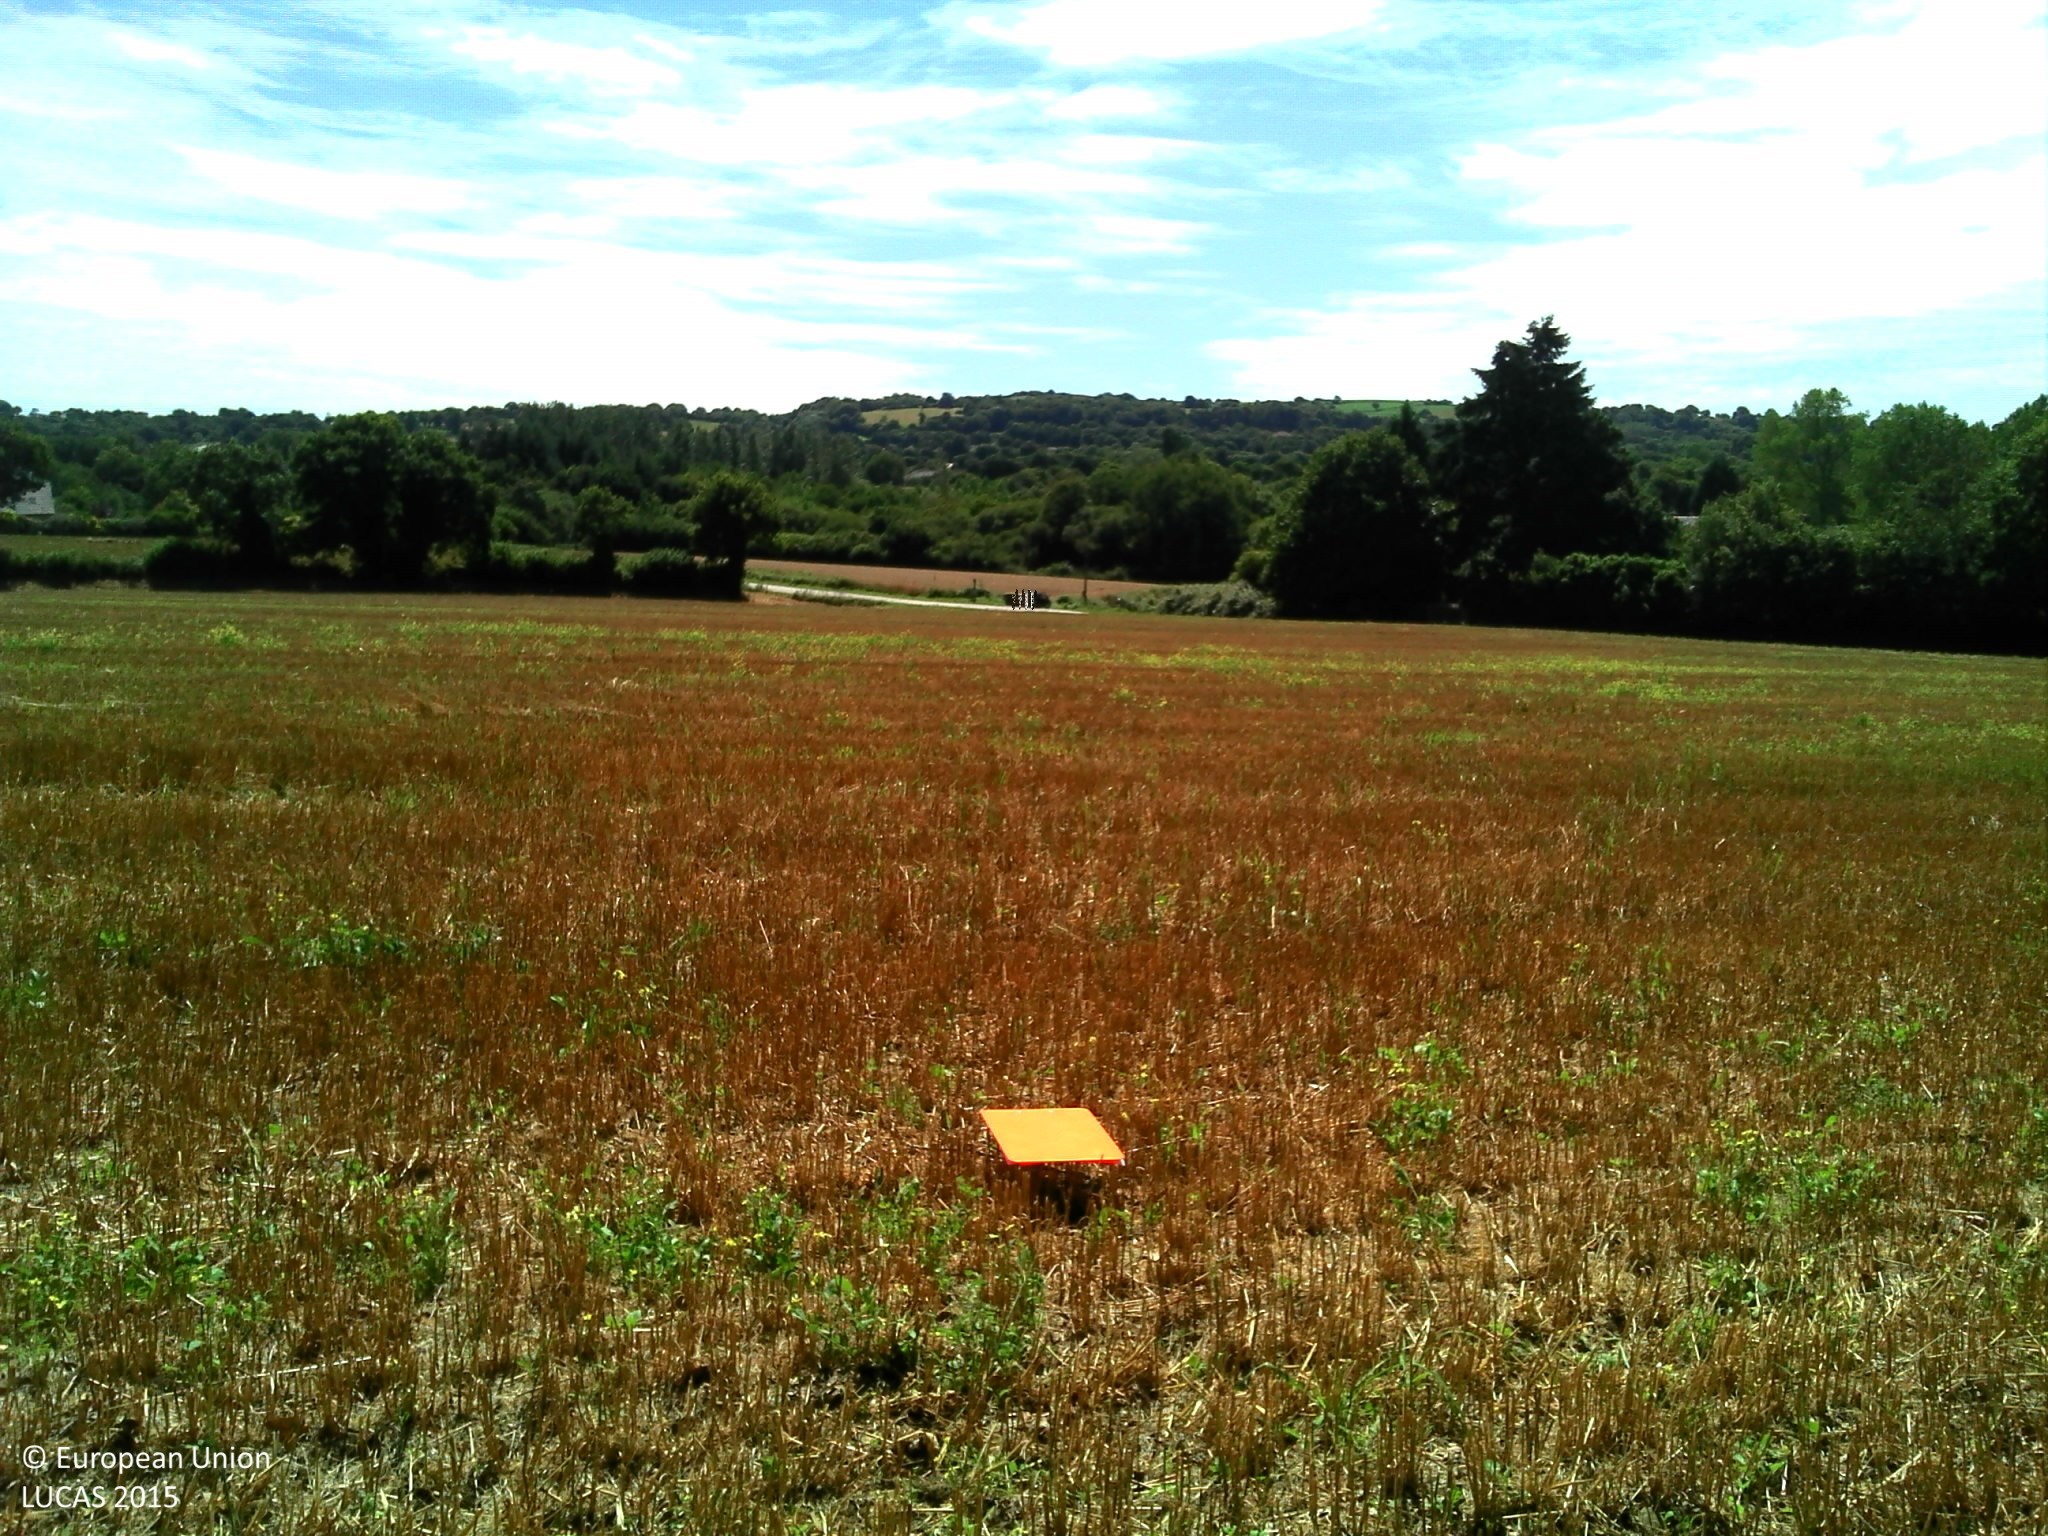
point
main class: Cropland
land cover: Barley
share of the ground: > 75 %
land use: Agriculture (excluding fallow land and kitchen gardens)
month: August
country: FR
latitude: 48.4800
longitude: -3.3750
